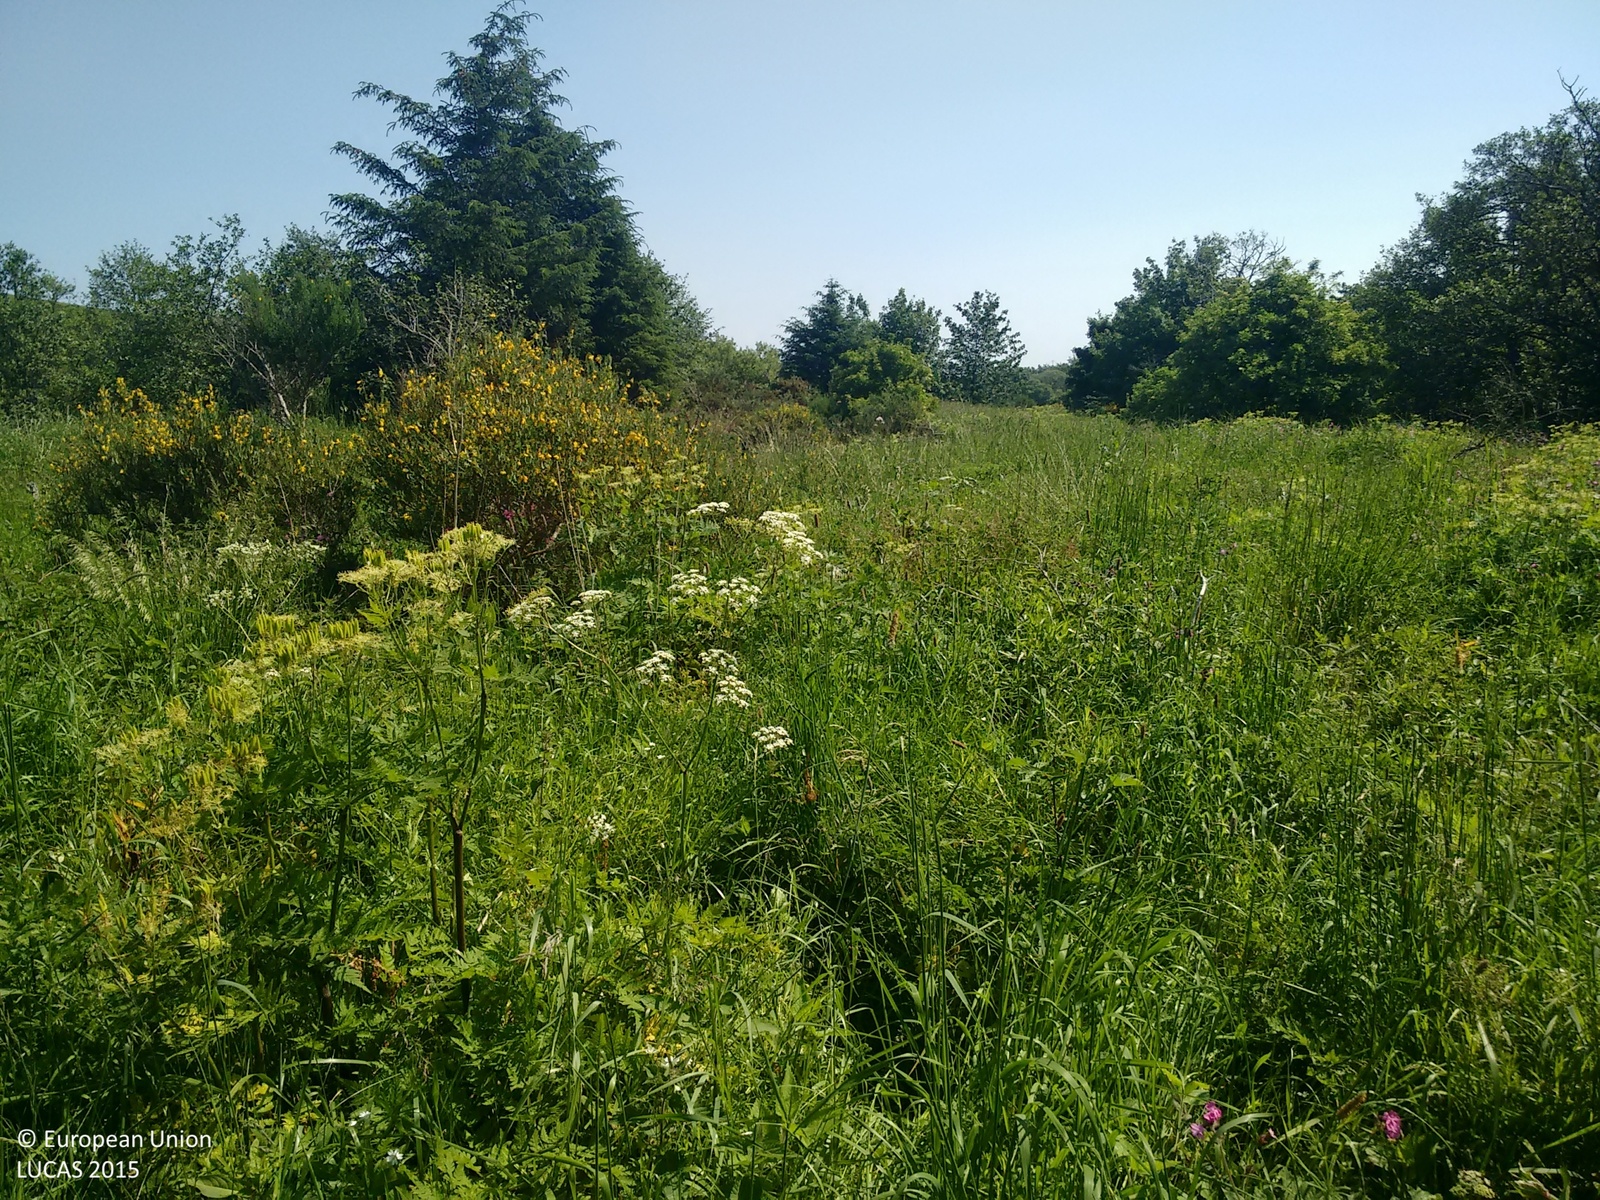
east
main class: Woodland
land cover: Broadleaved woodland
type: mesophytic deciduous forest
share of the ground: > 75 %
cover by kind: herbaceous plants 60 %, broadleaved forest trees 30 %, shrubs 10 %
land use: Semi-natural and natural areas not in use
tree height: > 5 m
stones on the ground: < 10 %
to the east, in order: Broadleaved woodland; Electric lines; Spontaneously vegetated surfaces; Broadleaved woodland
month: July
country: GB
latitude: 57.4509
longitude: -2.8745
